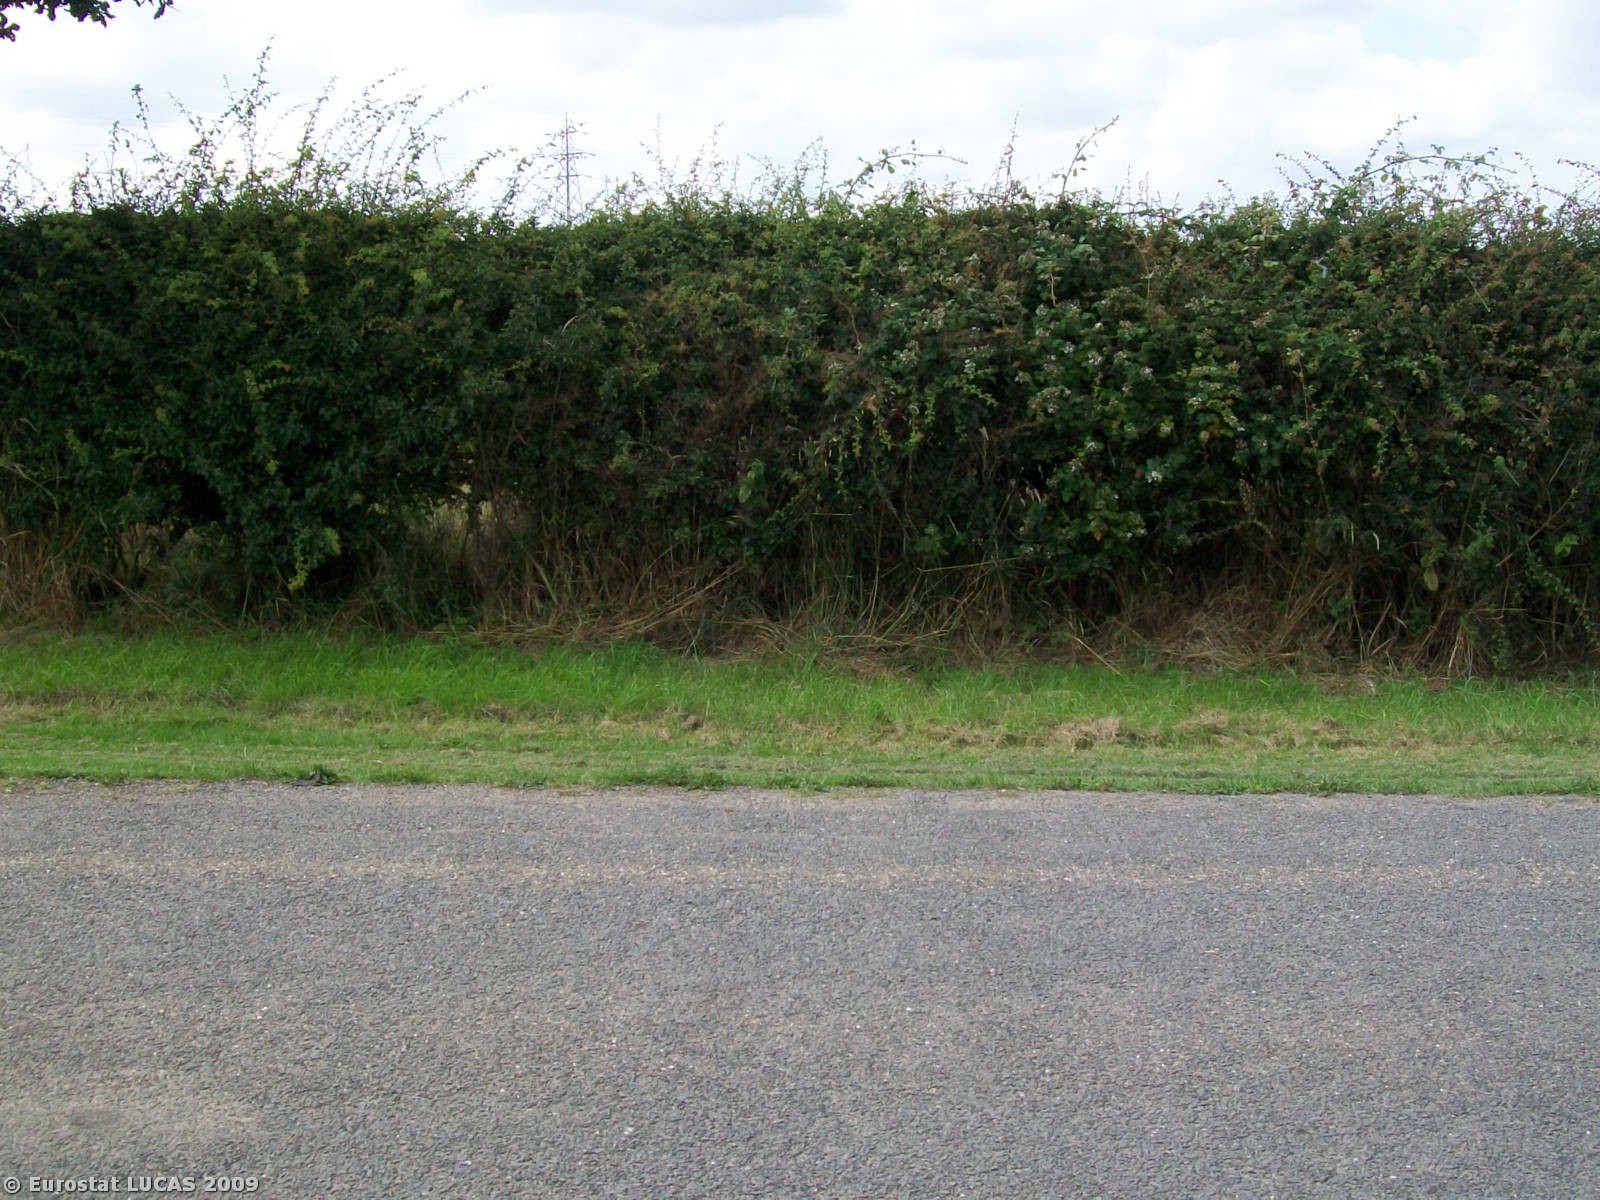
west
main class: Grassland
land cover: Grassland without tree/shrub cover
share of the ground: > 75 %
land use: Agriculture (excluding fallow land and kitchen gardens)
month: July
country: GB
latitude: 53.0873
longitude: -0.9274
